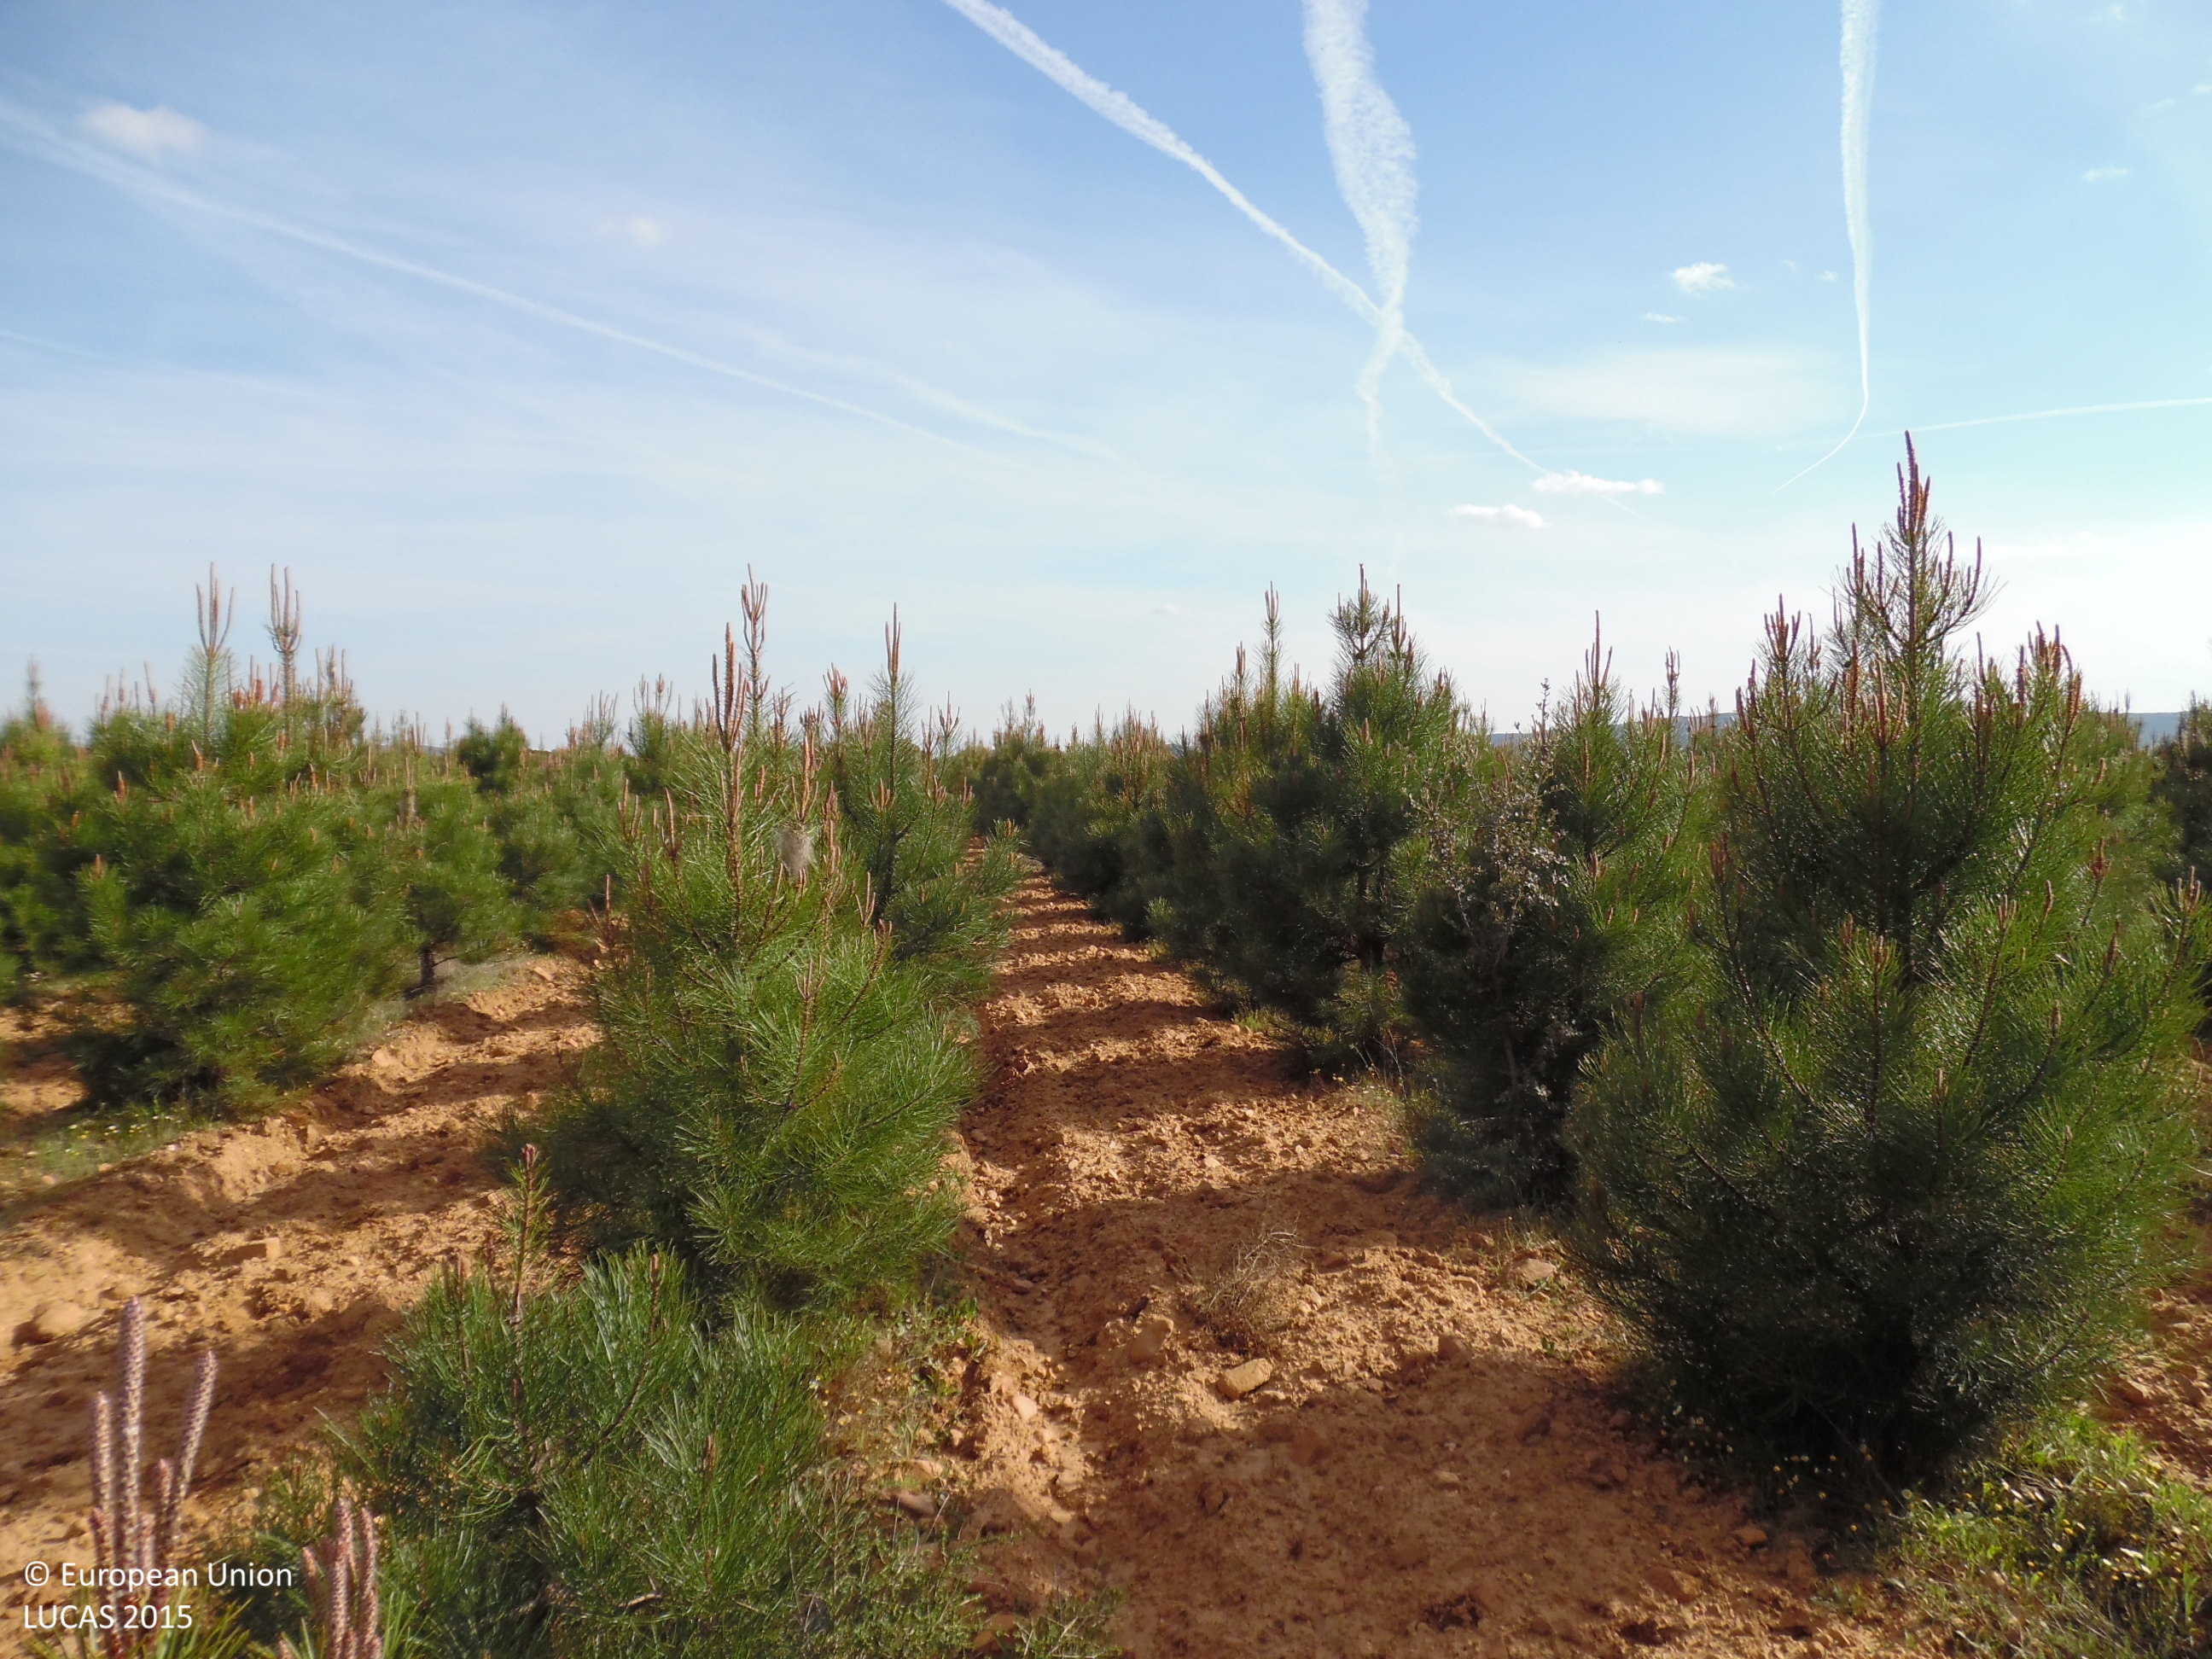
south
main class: Woodland
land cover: Pine dominated coniferous woodland
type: coniferous forest of the mediterranean region
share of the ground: > 75 %
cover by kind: coniferous forest trees 70 %, herbaceous plants 30 %
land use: Forestry
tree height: < 5 m
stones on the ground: < 10 %
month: April
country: ES
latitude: 42.2617
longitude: -6.0690
